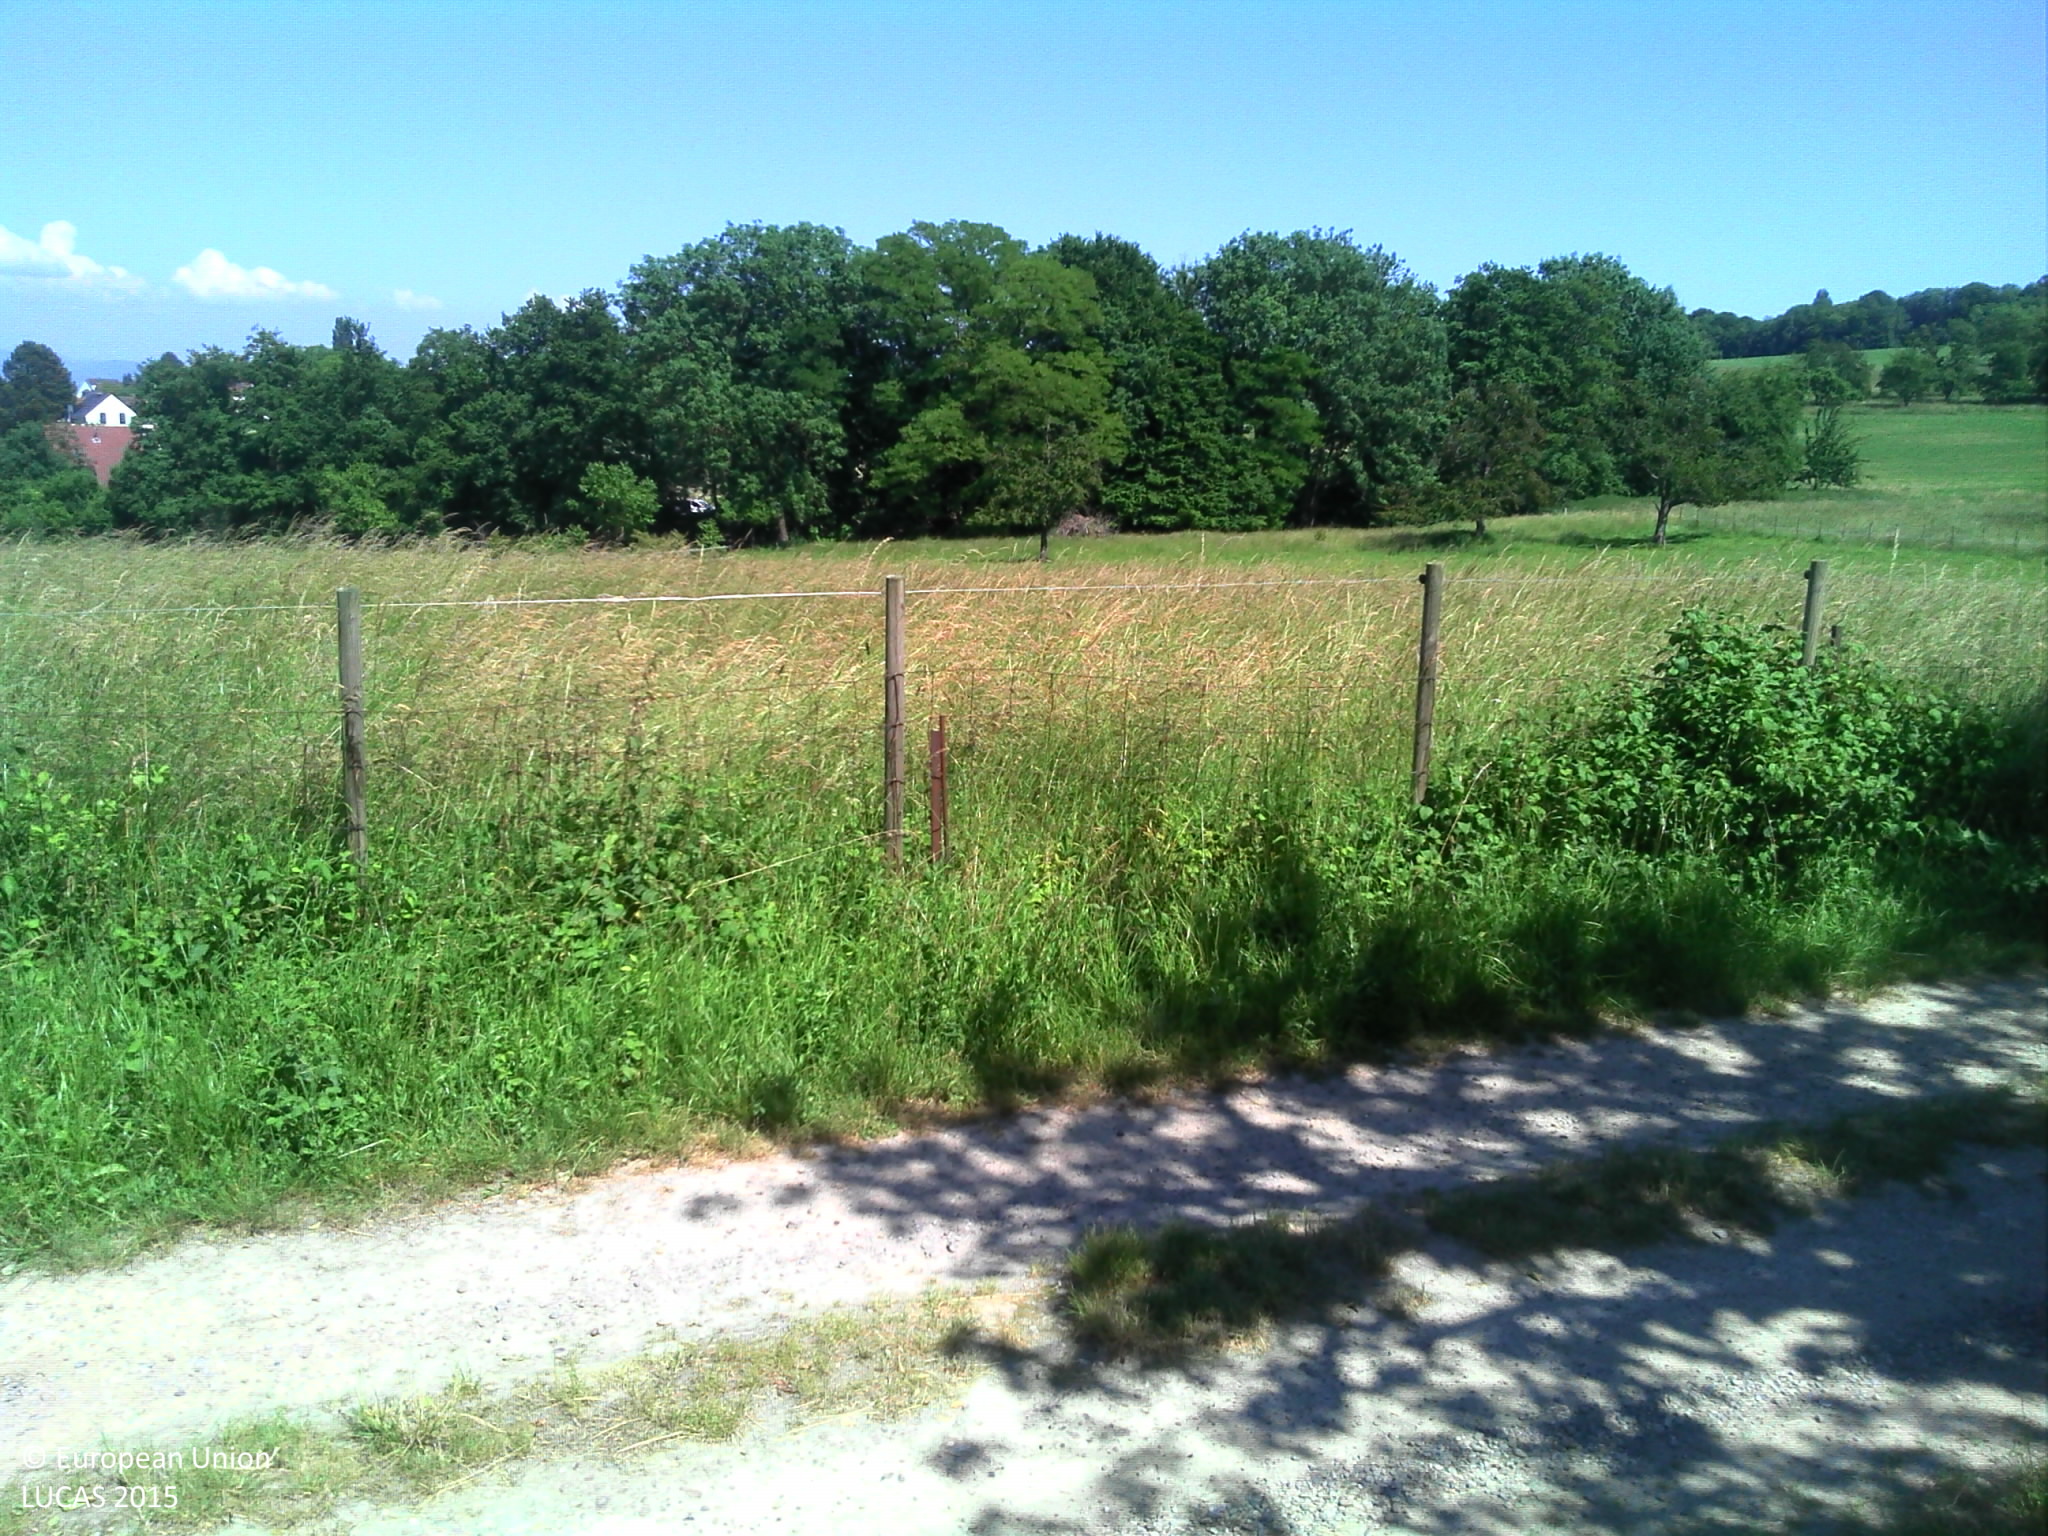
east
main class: Cropland
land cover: Cherry fruit
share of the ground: > 75 %
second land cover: Grassland without tree/shrub cover
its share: > 75 %
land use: Agriculture (excluding fallow land and kitchen gardens)
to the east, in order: Cherry fruit; Grassland without tree/shrub cover; Grass margins; Tracks; Grass margins; Fences; Grassland without tree/shrub cover; Fences; Broadleaved woodland; Potatoes; Grass margins; Tracks; Grass margins; Maize; Grassland without tree/shrub cover; Lines of trees; Temporary grasslands
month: June
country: FR
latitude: 47.6349
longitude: 7.4063
